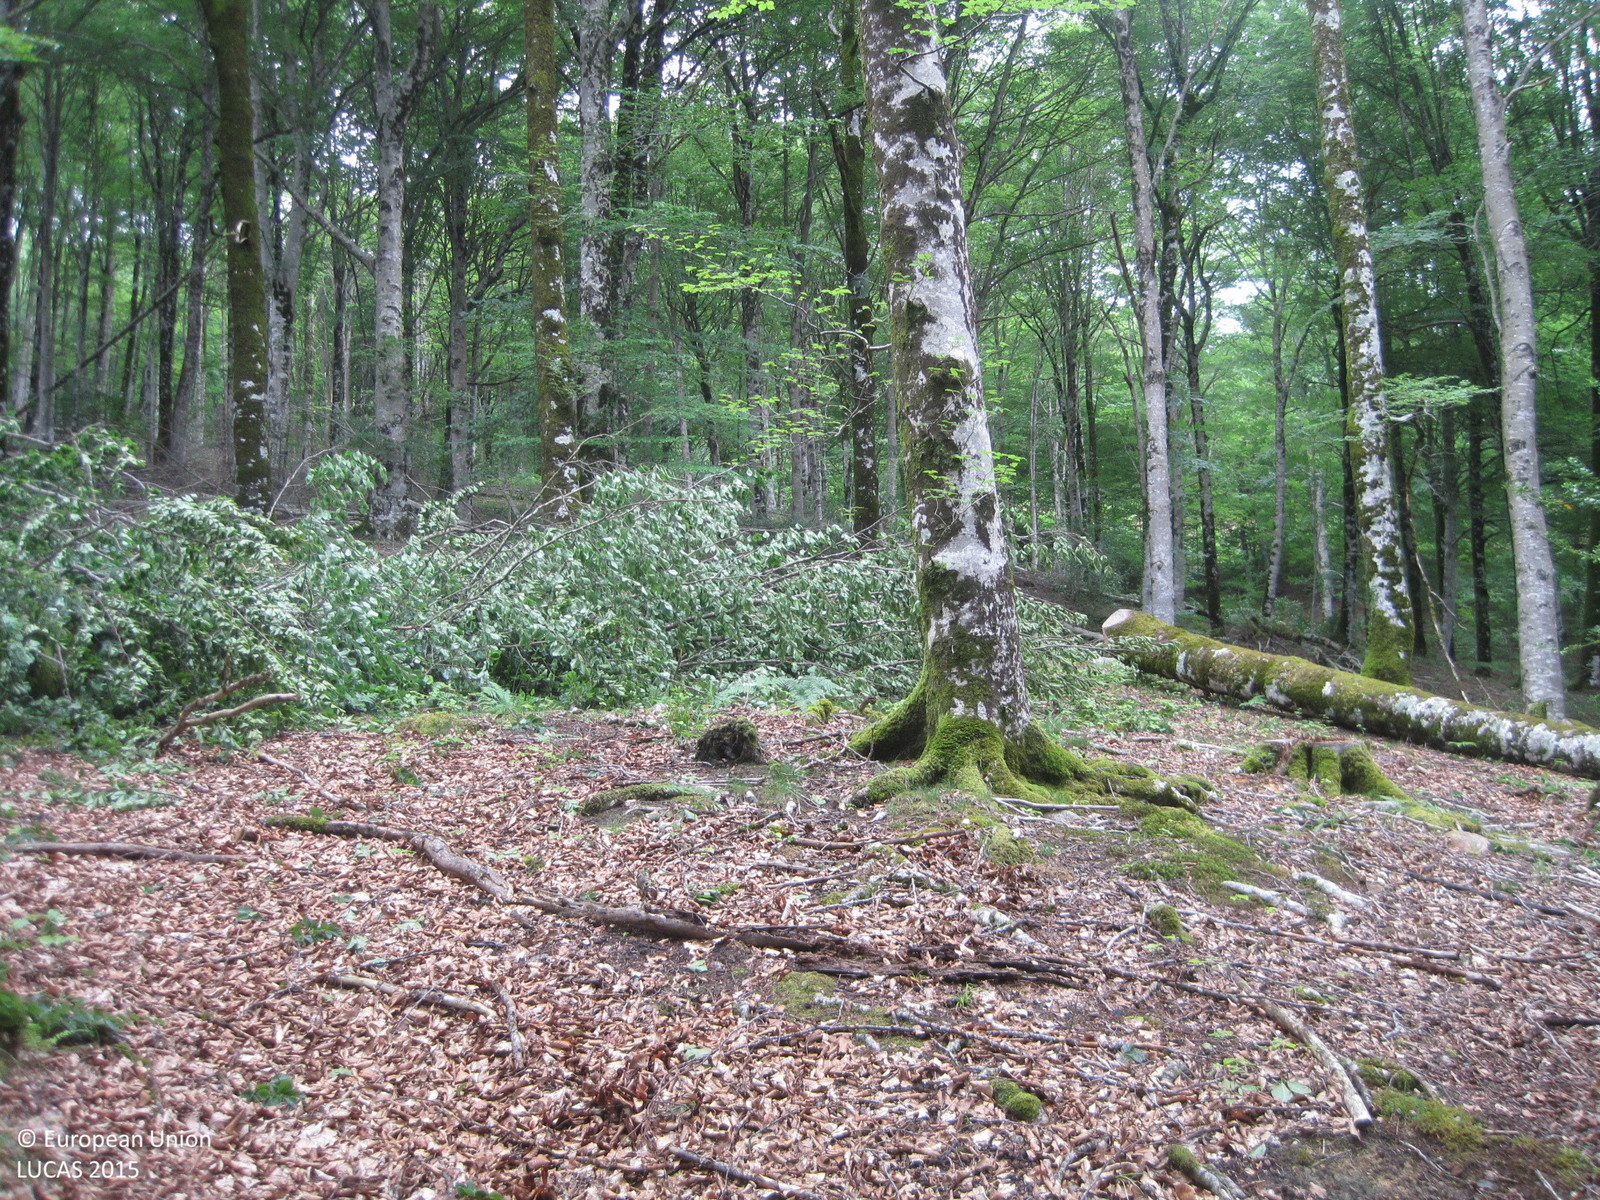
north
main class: Woodland
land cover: Broadleaved woodland
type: beech forest
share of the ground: > 75 %
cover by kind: broadleaved forest trees 100 %
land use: Forestry
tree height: > 5 m
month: June
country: ES
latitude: 42.9333
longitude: -2.2142
